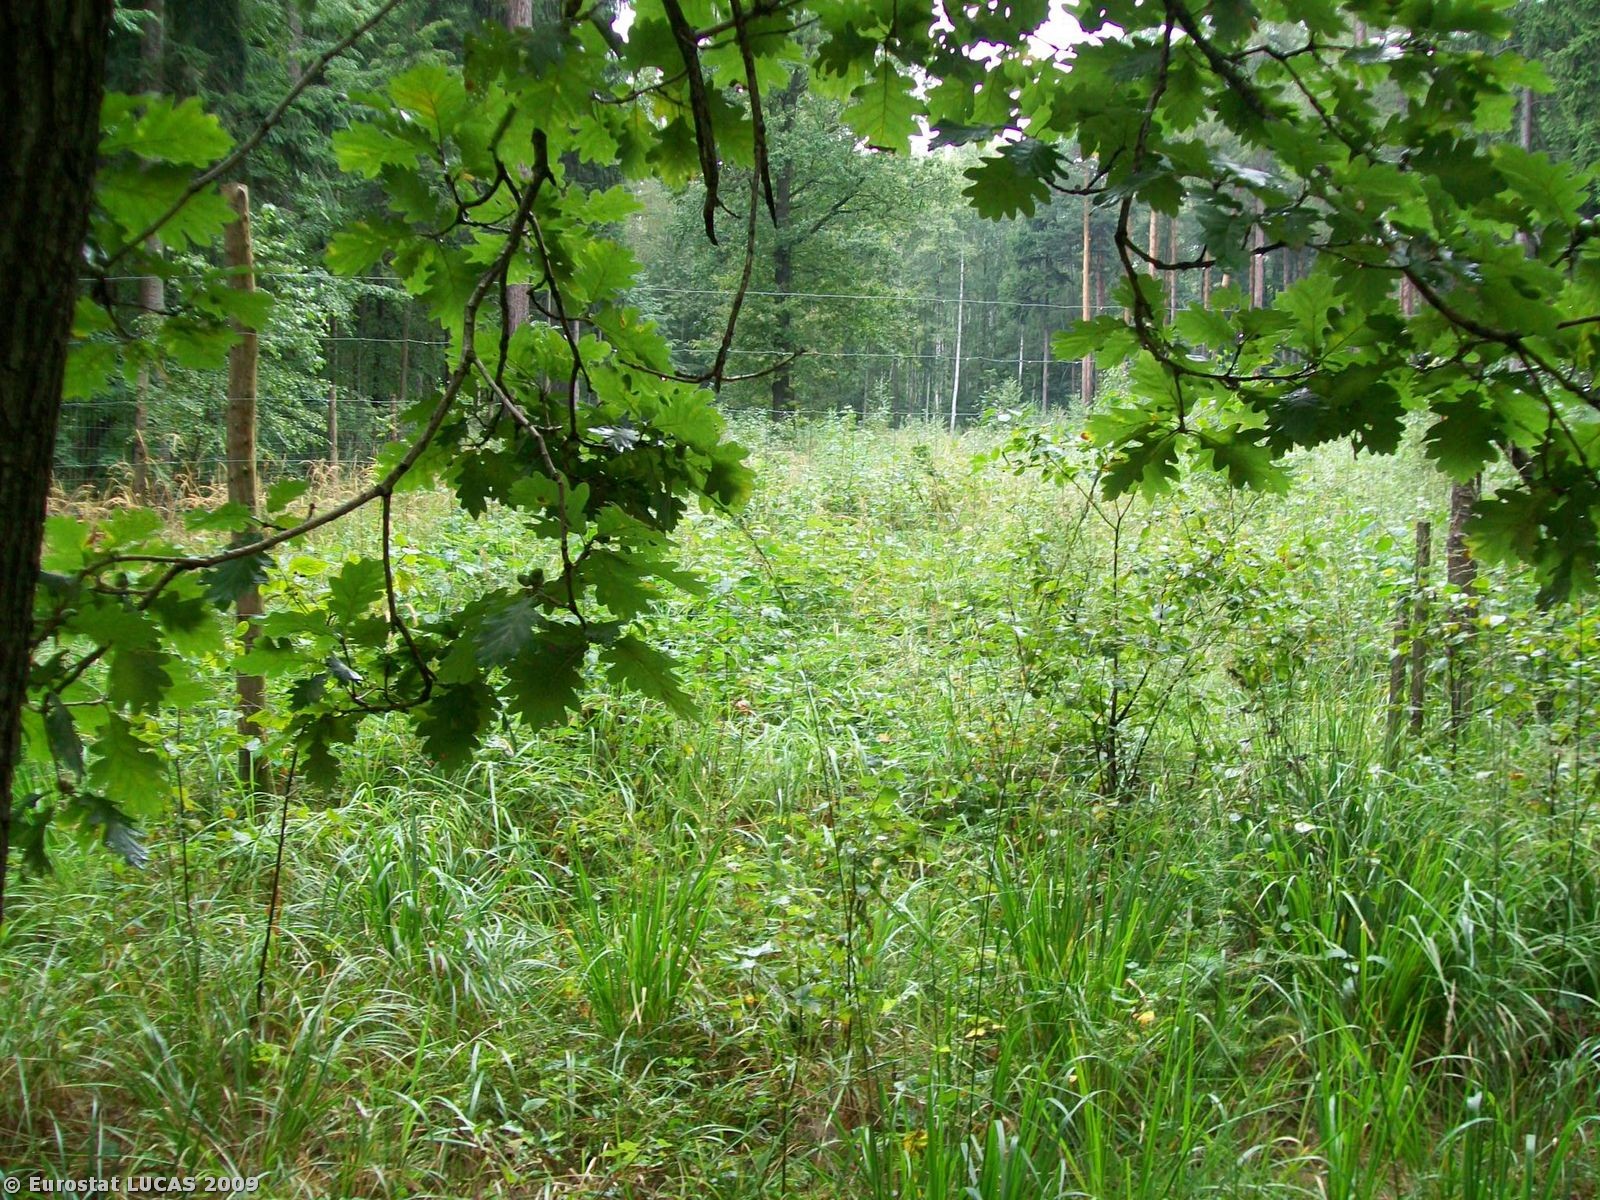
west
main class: Woodland
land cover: Mixed woodland
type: hemiboreal forest and nemoral coniferous forest and mixed broadleaved-coniferous forest
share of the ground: > 75 %
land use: Forestry
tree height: > 5 m
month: September
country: PL
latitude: 50.7409
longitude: 16.7684
